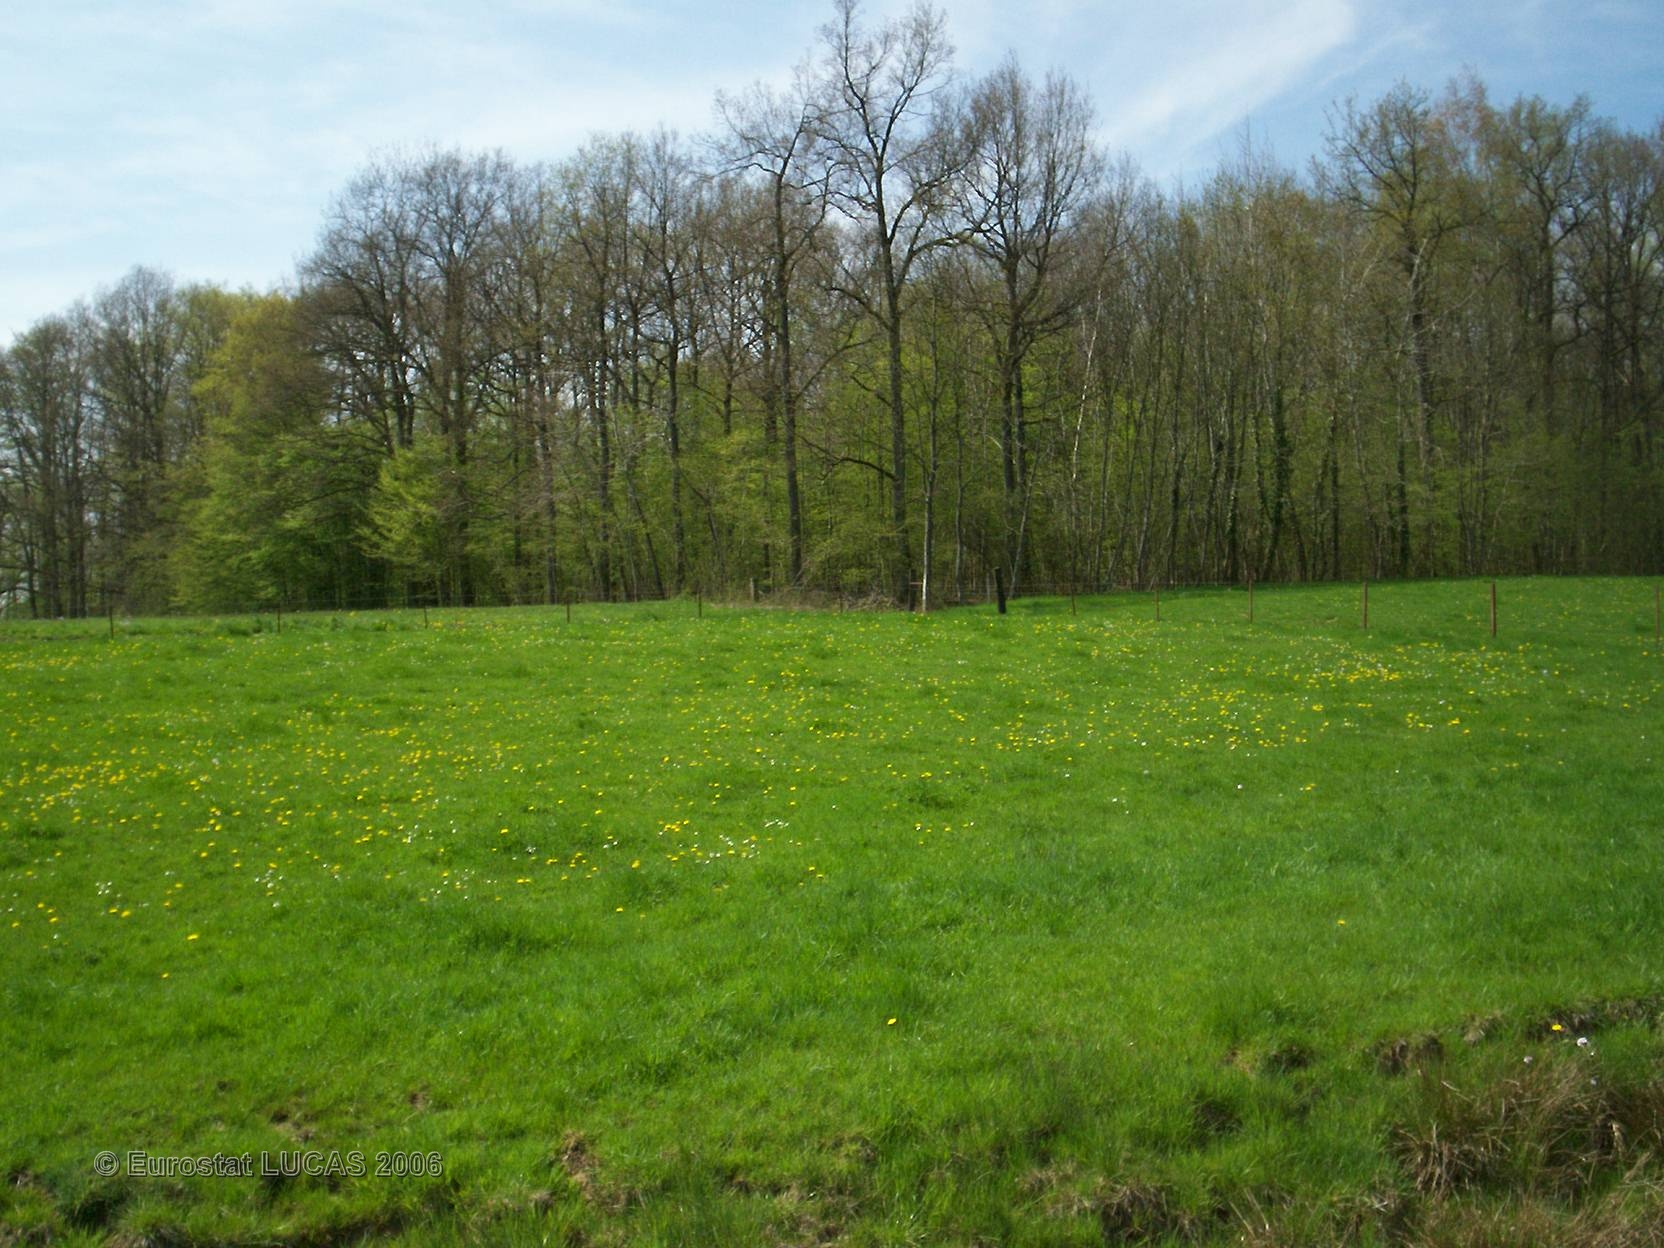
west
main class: Grassland
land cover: Grassland without tree/shrub cover
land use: Agriculture (excluding fallow land and kitchen gardens)
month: April
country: FR
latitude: 49.7183
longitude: 4.3228
